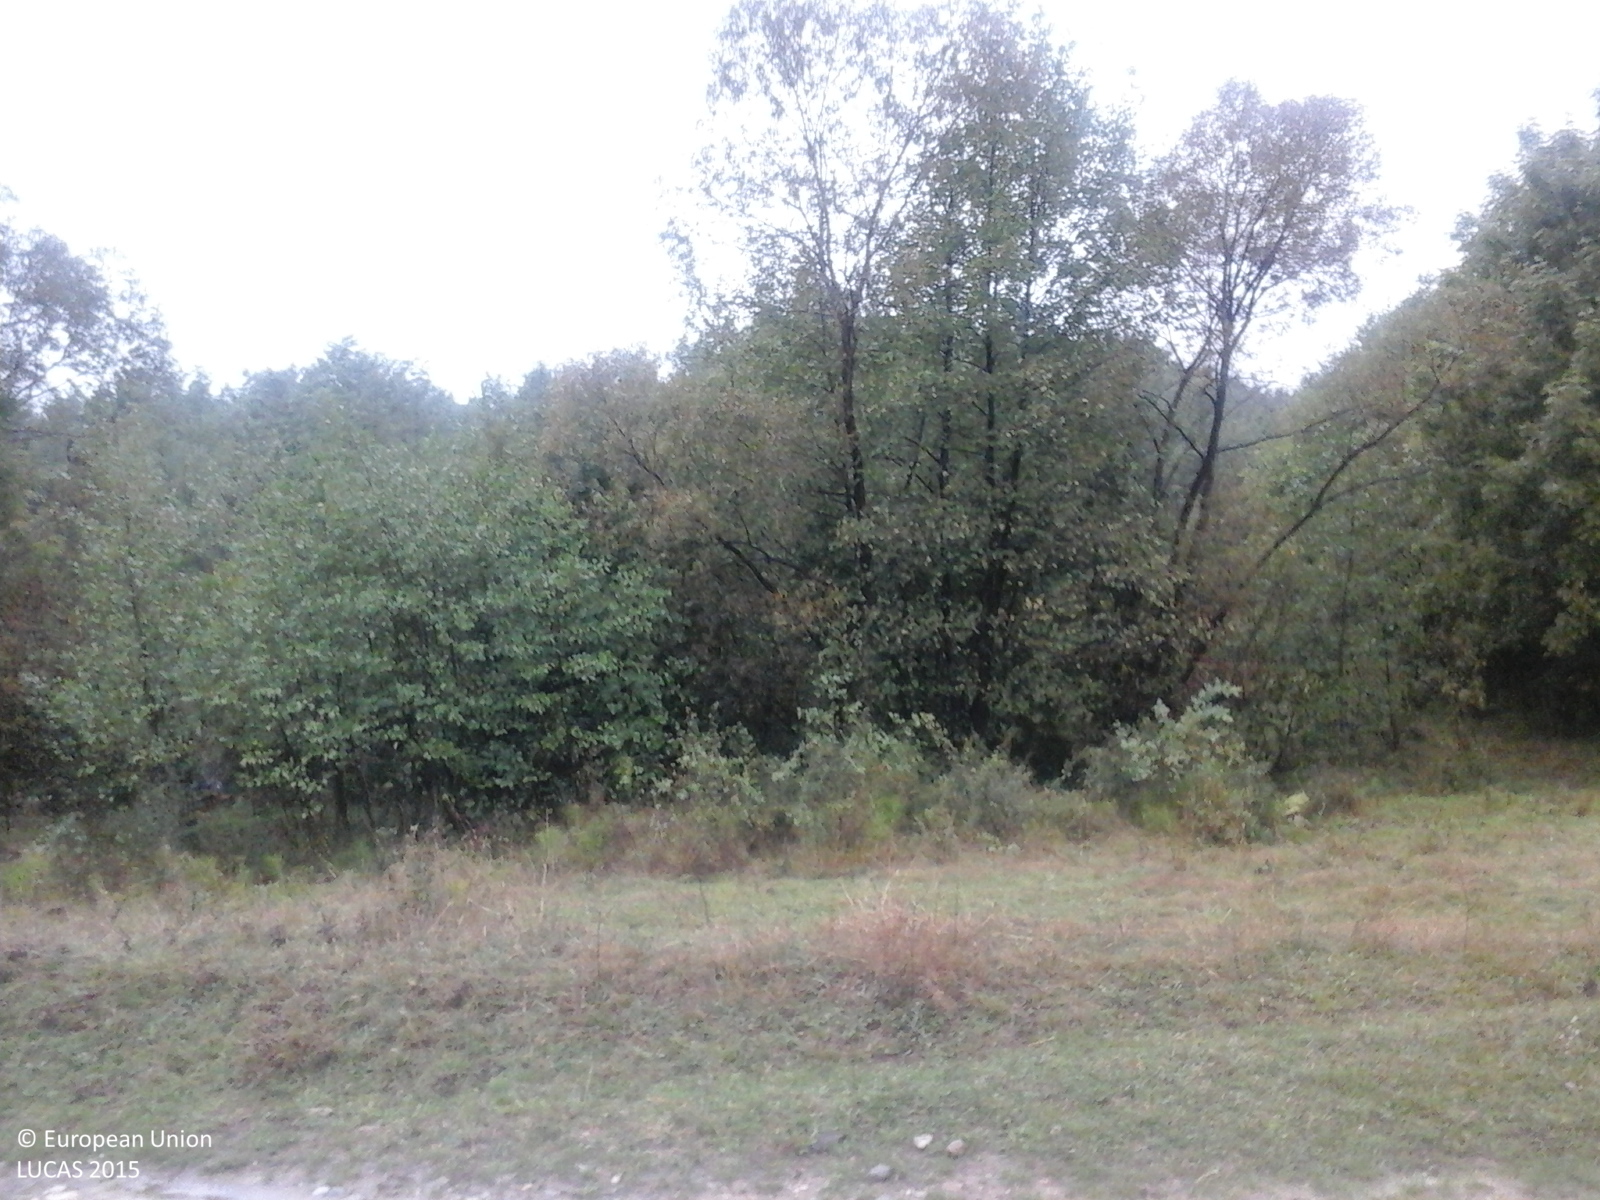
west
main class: Grassland
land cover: Grassland with sparse tree/shrub cover
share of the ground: > 75 %
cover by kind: herbaceous plants 95 %, broadleaved forest trees 5 %
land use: Agriculture (excluding fallow land and kitchen gardens)
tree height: < 5 m
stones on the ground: < 10 %
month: September
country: RO
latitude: 45.1529
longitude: 23.7103
